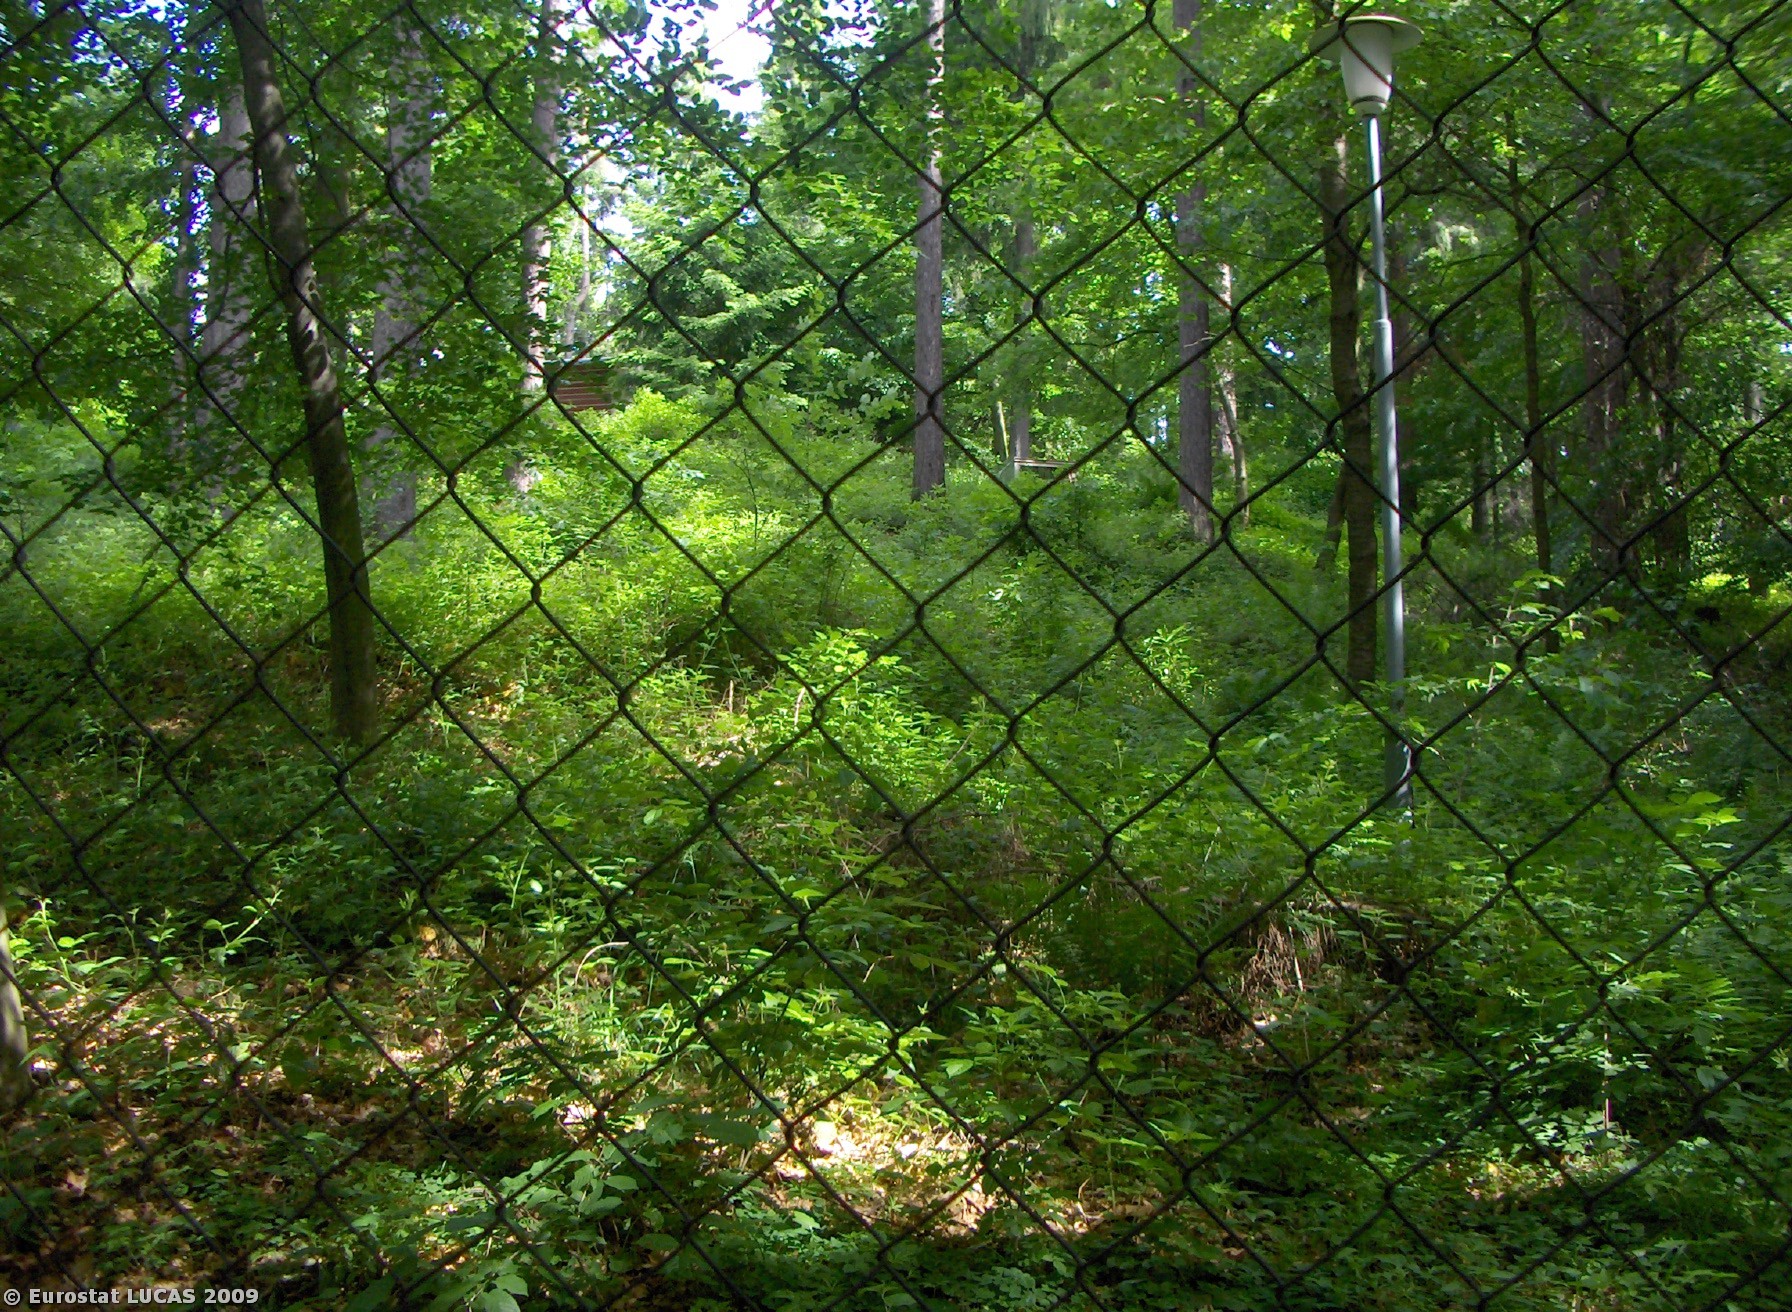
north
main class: Woodland
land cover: Mixed woodland
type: hemiboreal forest and nemoral coniferous forest and mixed broadleaved-coniferous forest
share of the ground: > 75 %
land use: Community services
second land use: Forestry
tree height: > 5 m
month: May
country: CZ
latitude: 49.3147
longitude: 14.1964
